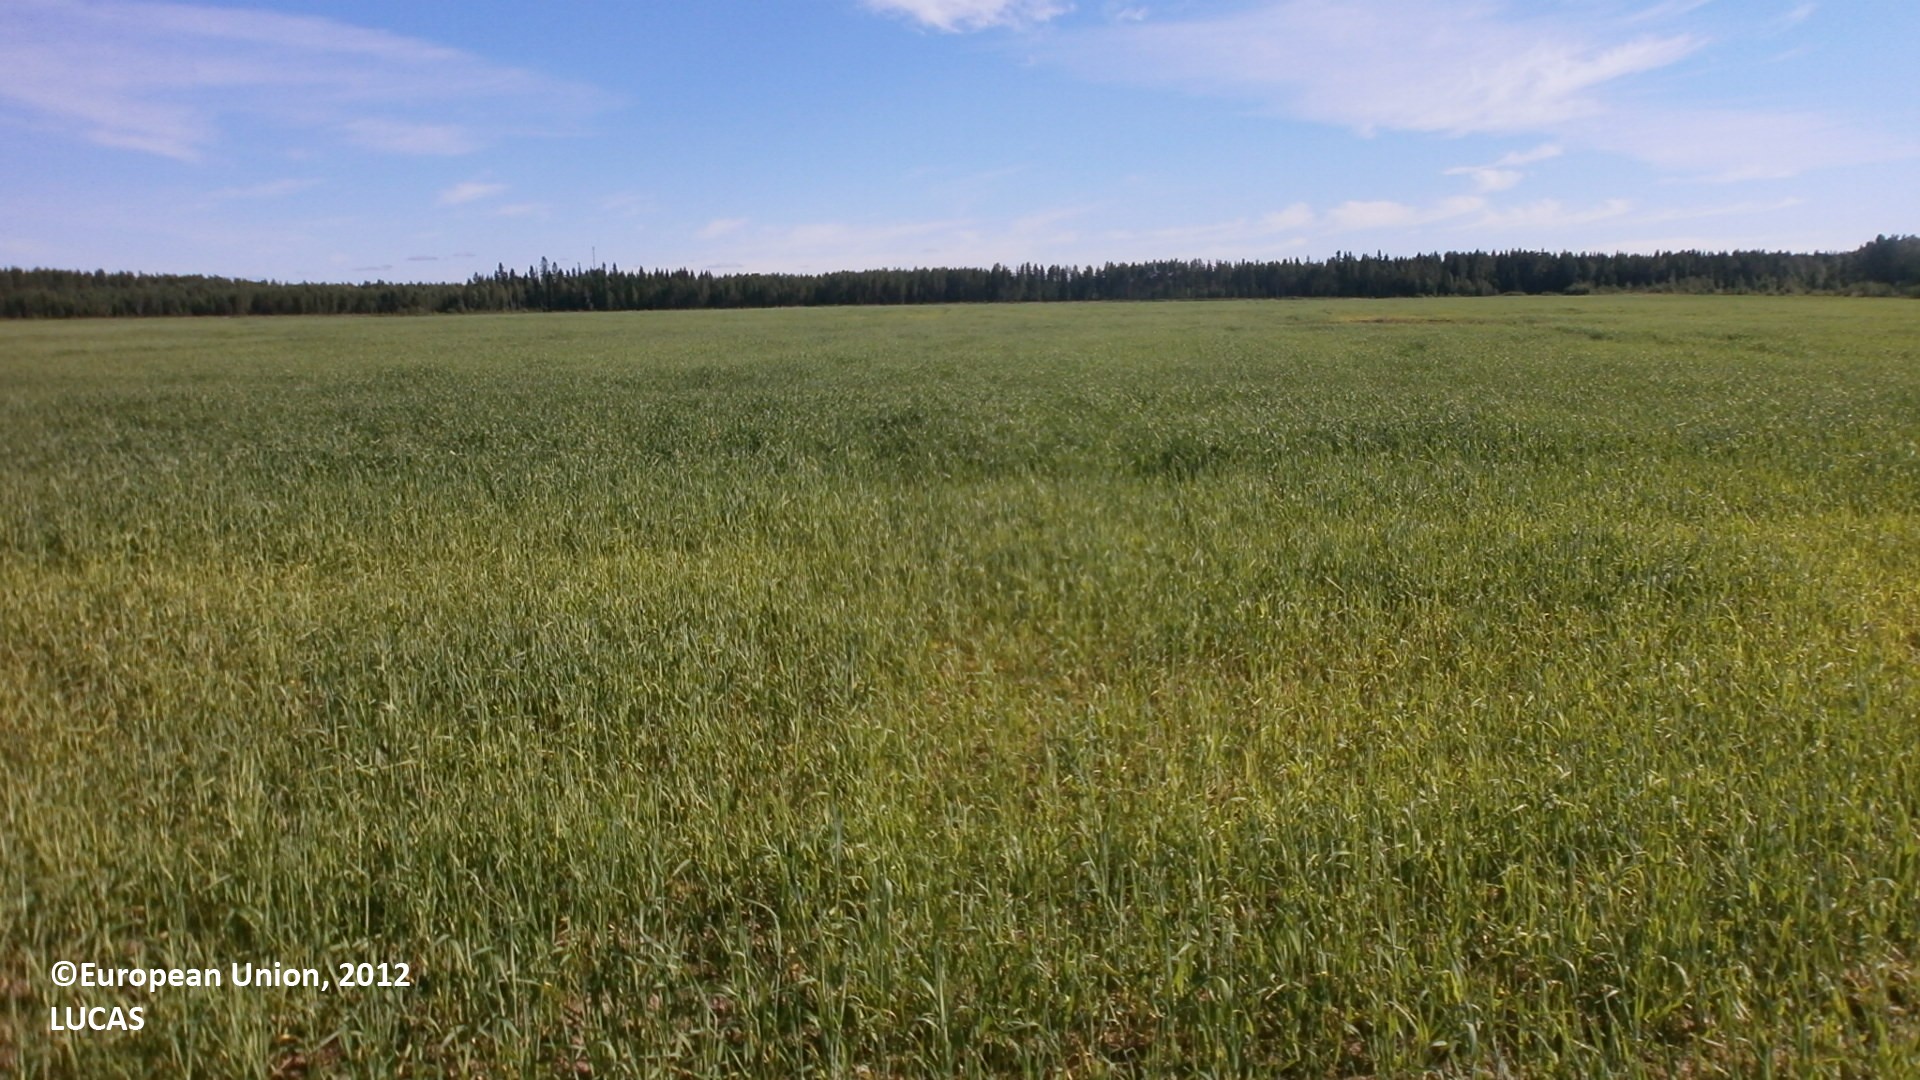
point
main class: Cropland
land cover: Barley
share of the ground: > 75 %
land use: Agriculture (excluding fallow land and kitchen gardens)
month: July
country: FI
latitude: 64.2954
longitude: 23.9267
